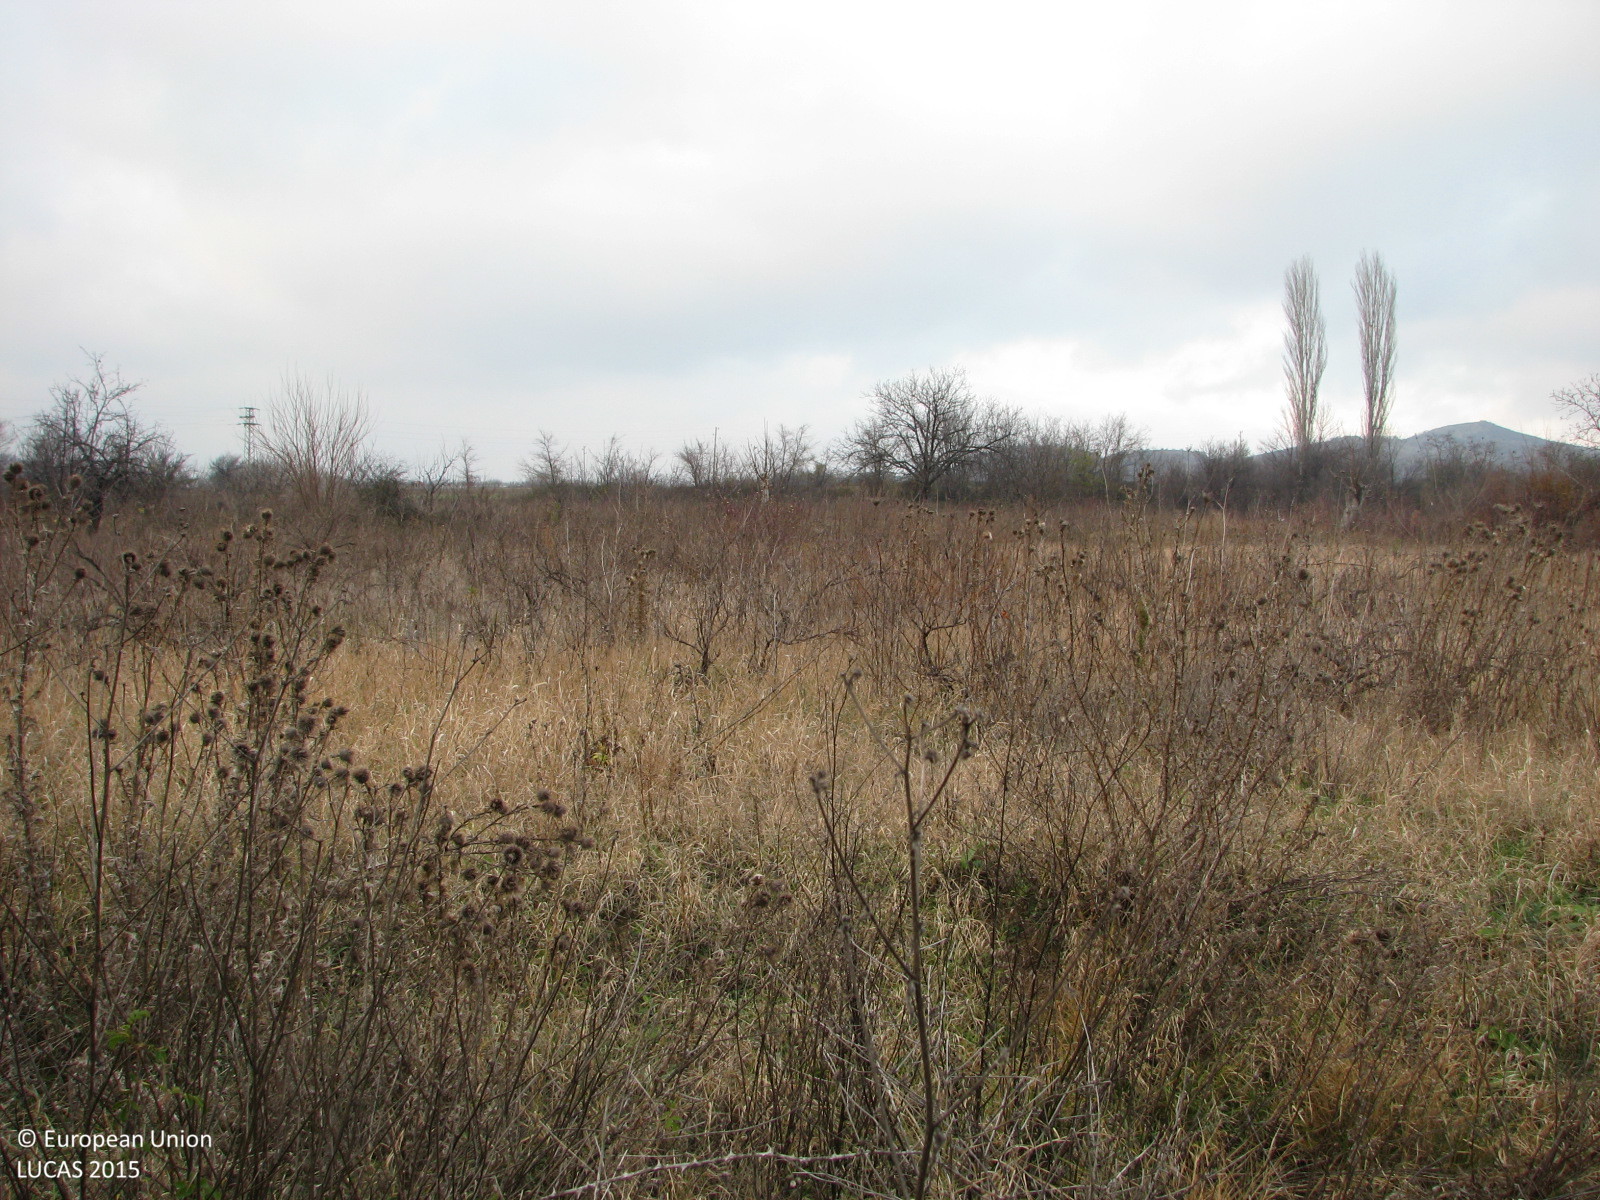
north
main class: Shrubland
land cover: Shrubland with sparse tree cover
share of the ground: 25 - 50 %
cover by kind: herbaceous plants 60 %, shrubs 35 %, broadleaved forest trees 5 %
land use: Fallow land
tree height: < 5 m
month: December
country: BG
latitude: 42.4551
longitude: 24.1871
